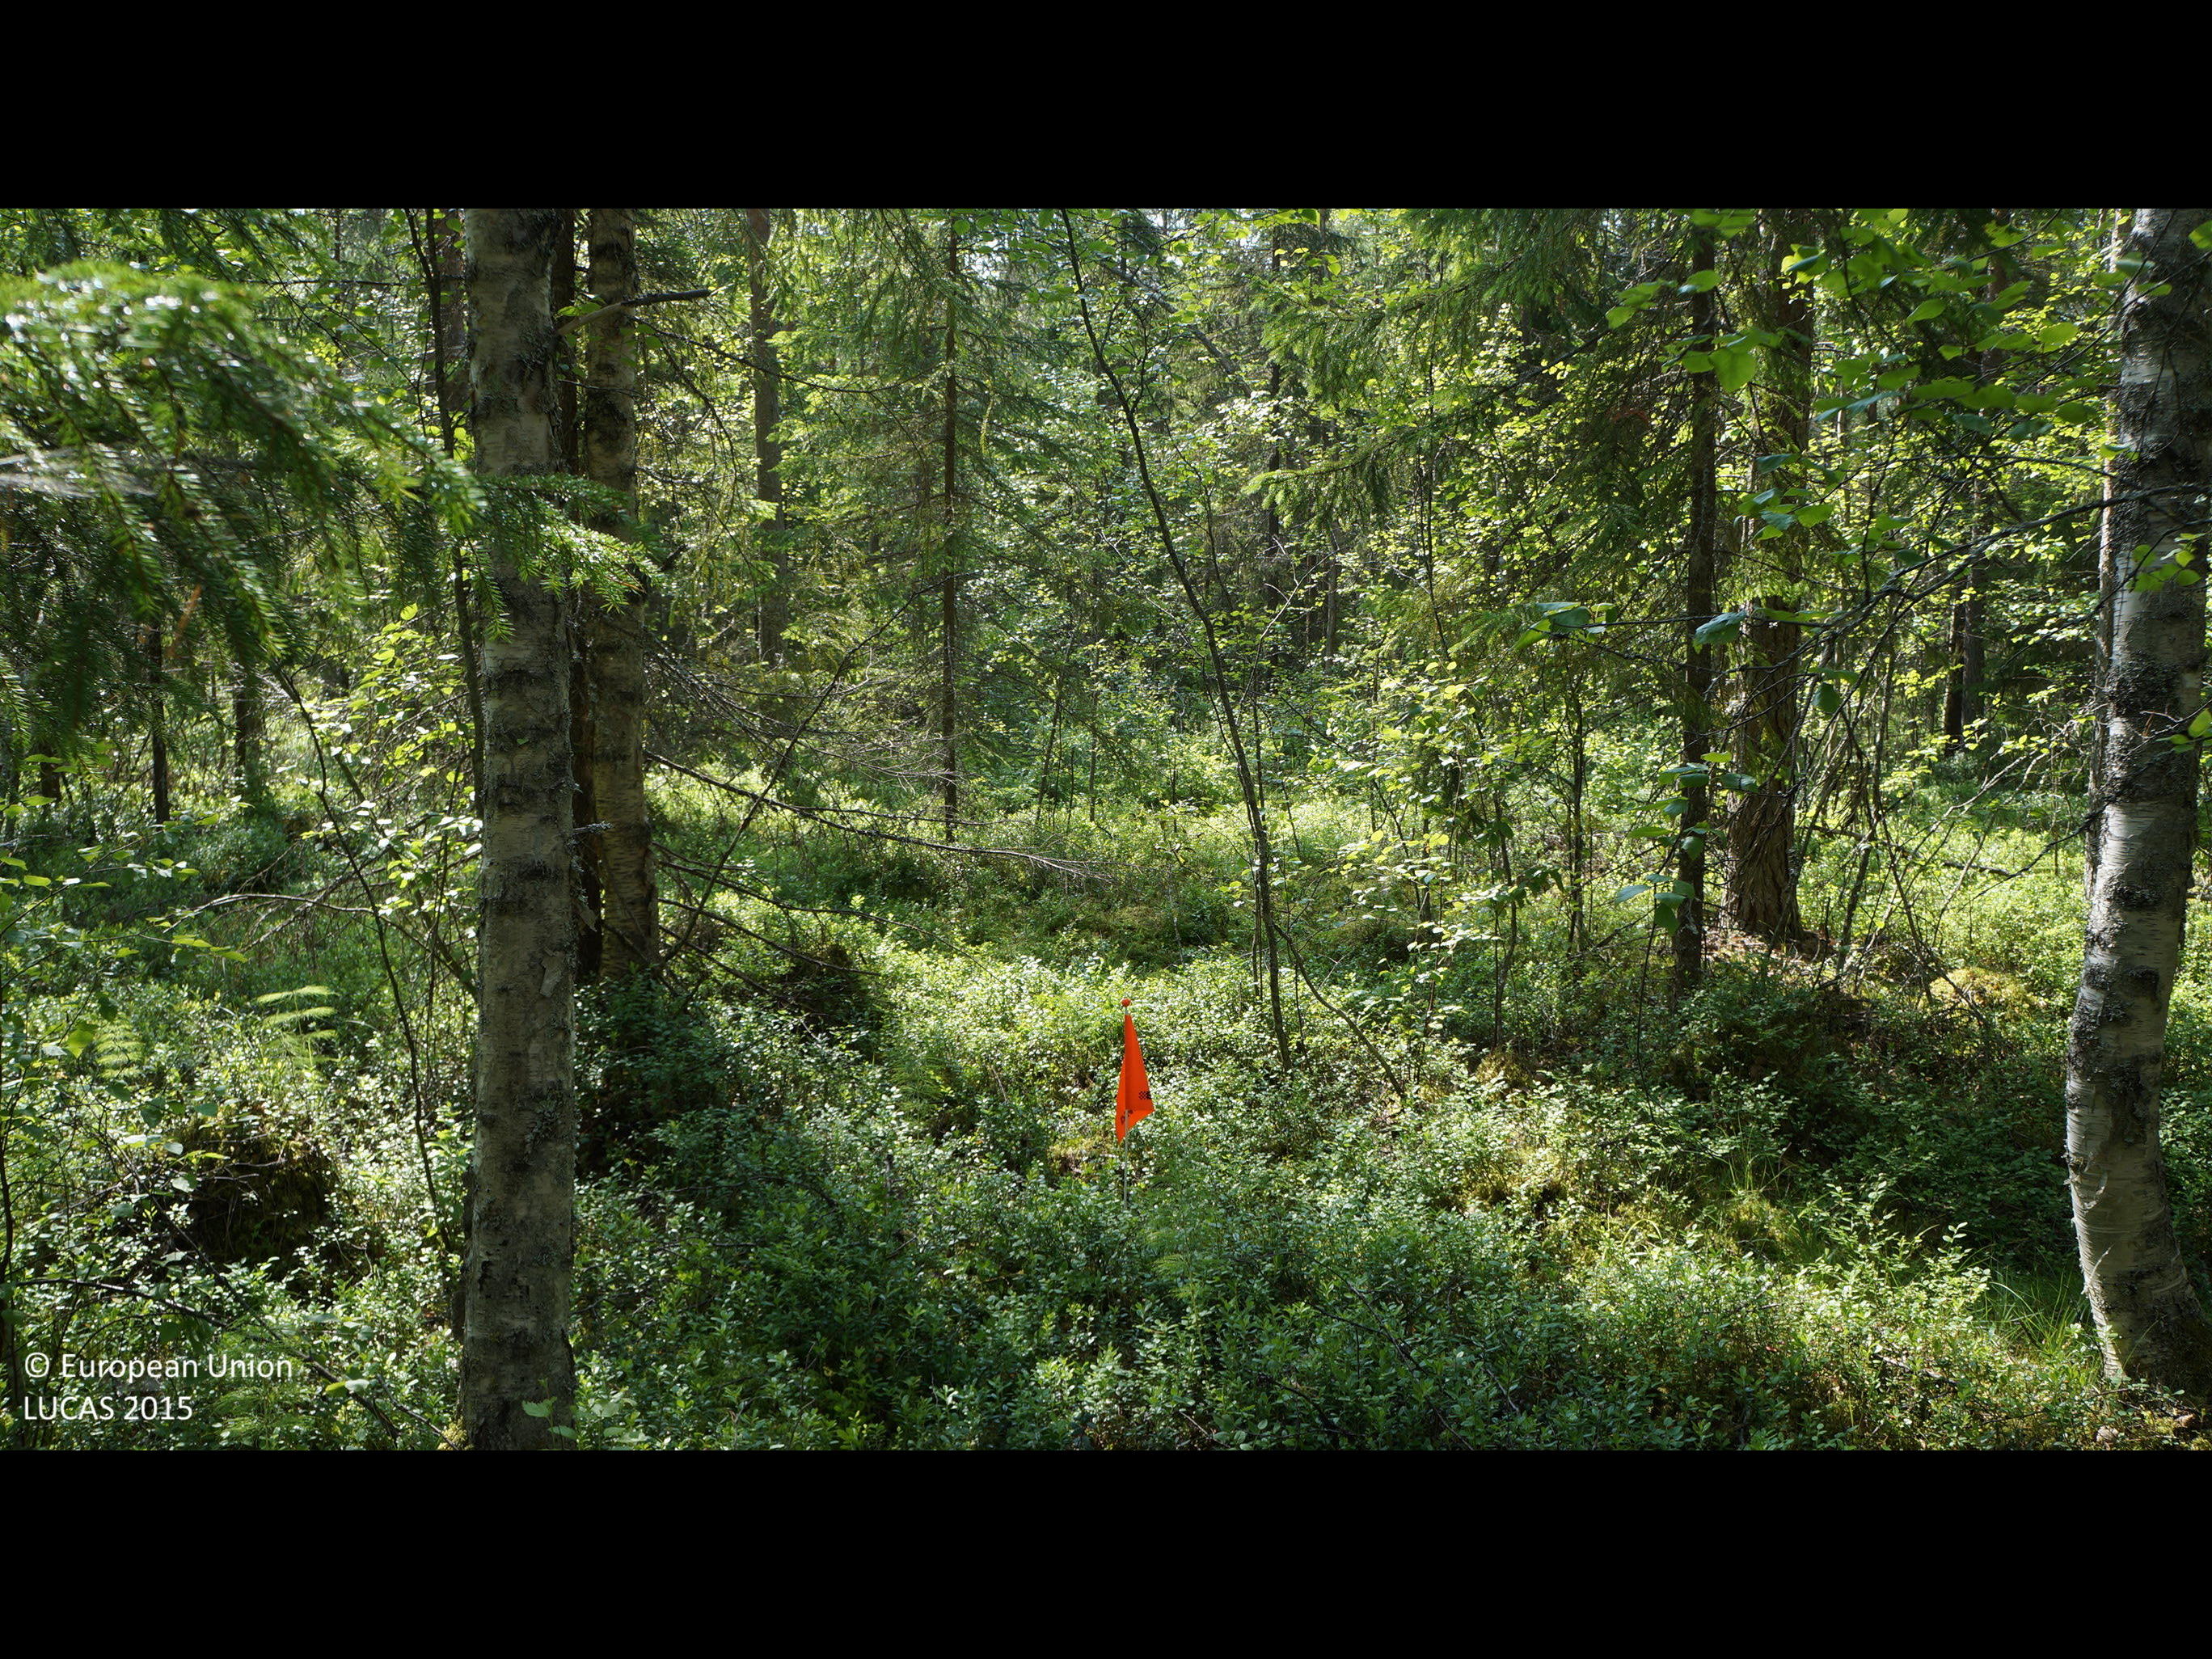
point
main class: Woodland
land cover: Pine dominated coniferous woodland
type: boreal forest
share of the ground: 50 - 75 %
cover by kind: coniferous forest trees 65 %, shrubs 20 %, broadleaved forest trees 5 %, herbaceous plants 5 %, lichens and mosses 5 %
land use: Forestry
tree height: > 5 m
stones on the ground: < 10 %
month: July
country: FI
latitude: 64.4953
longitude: 24.3665
